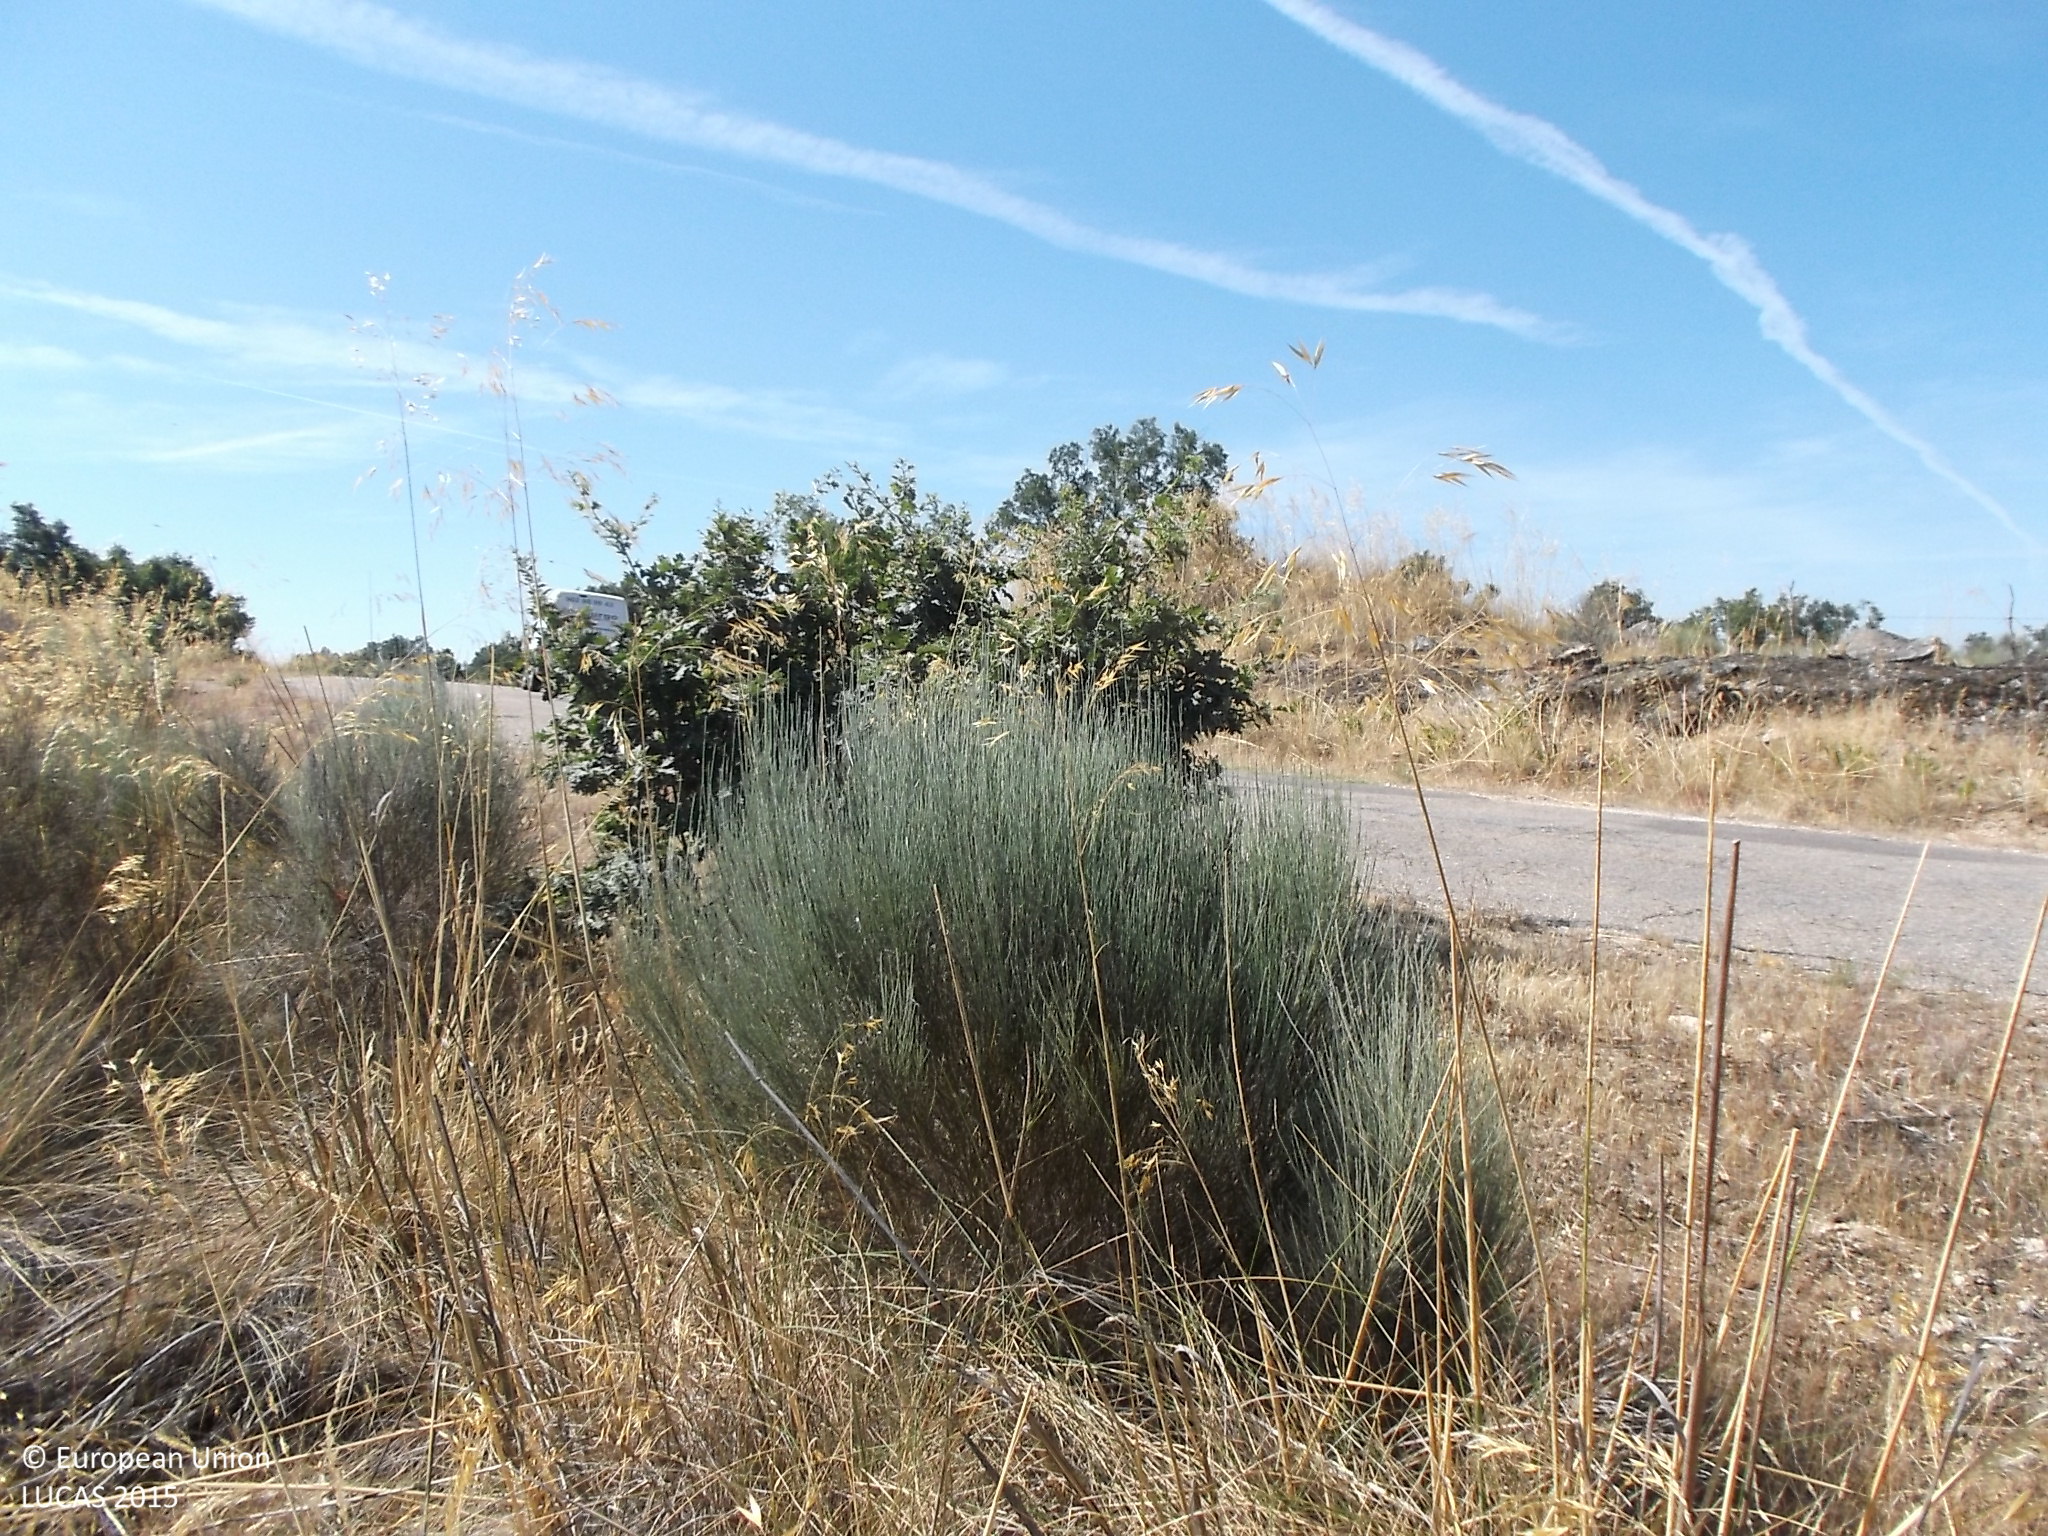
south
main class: Shrubland
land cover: Shrubland with sparse tree cover
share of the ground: > 75 %
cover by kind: shrubs 80 %, herbaceous plants 15 %, broadleaved forest trees 5 %
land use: Agriculture (excluding fallow land and kitchen gardens)
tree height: < 5 m
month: July
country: ES
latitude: 41.2203
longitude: -6.4756
